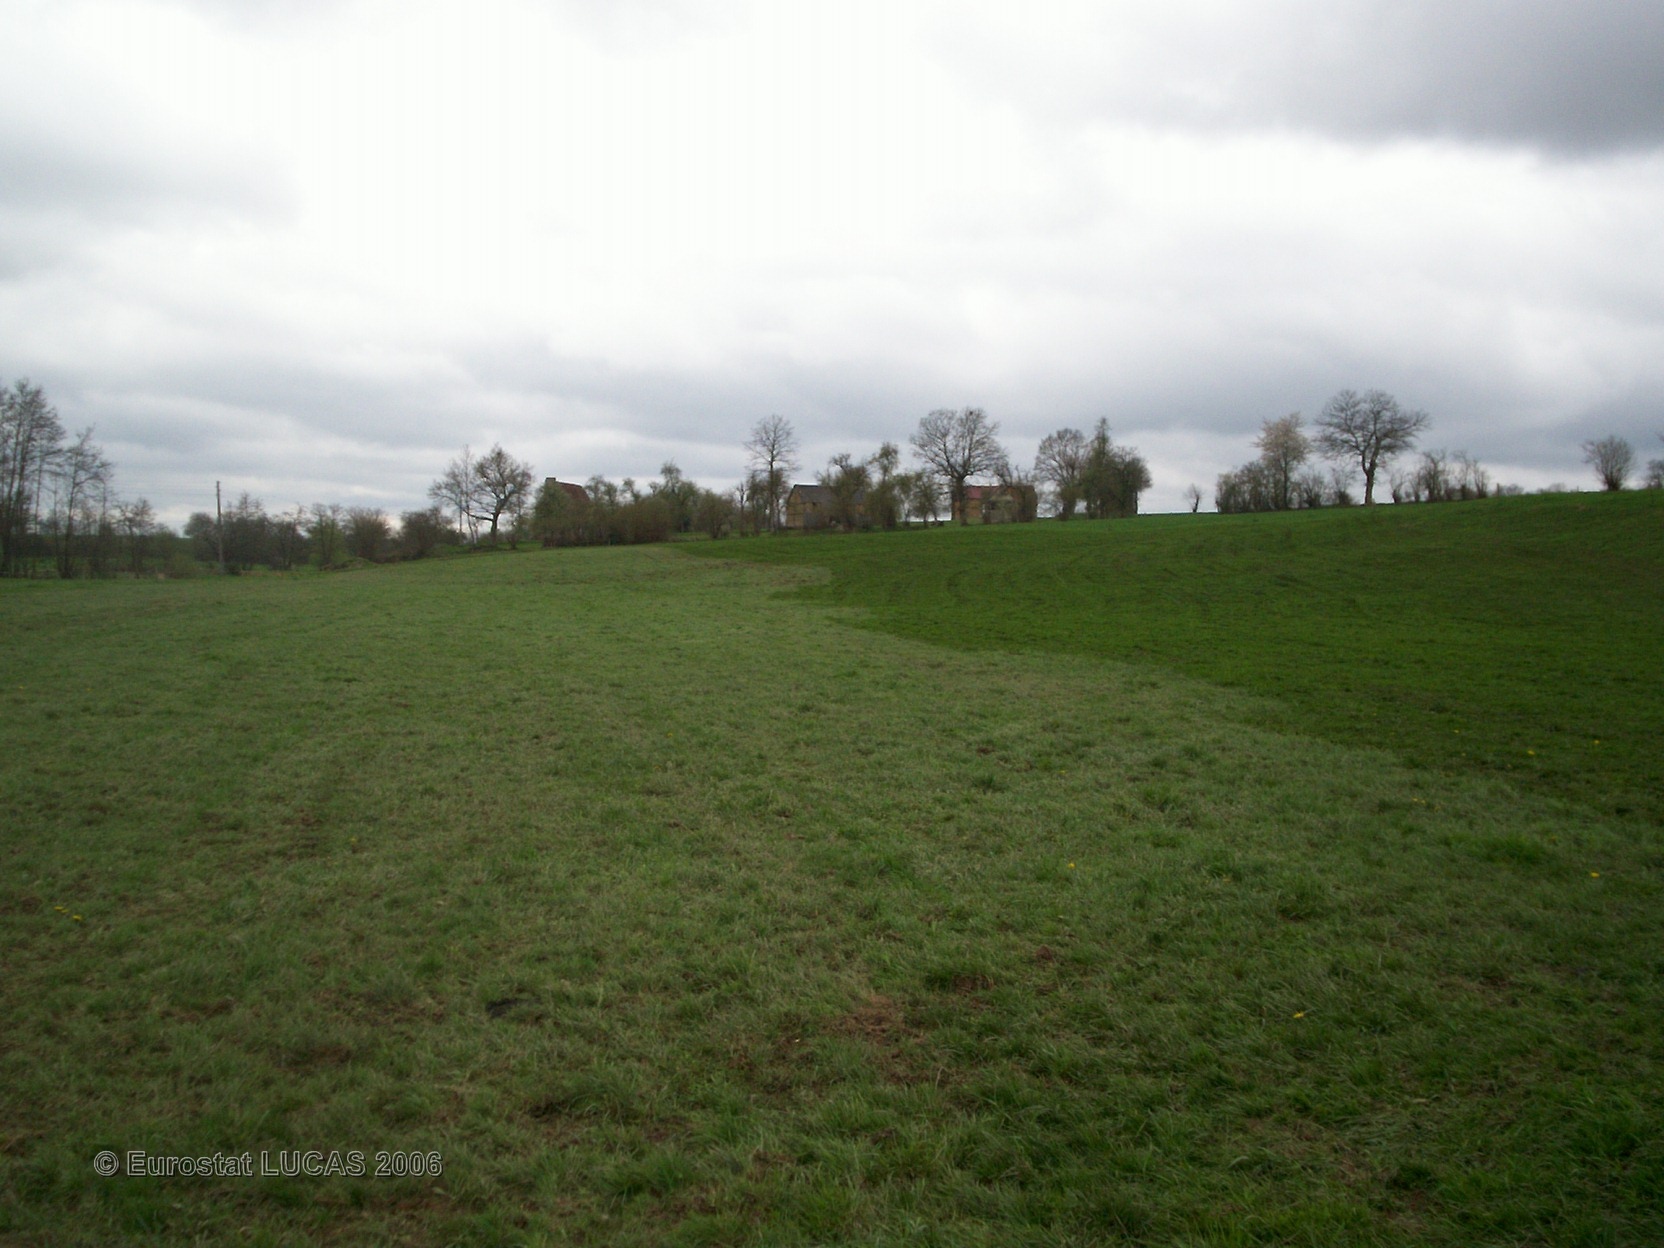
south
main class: Grassland
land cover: Grassland without tree/shrub cover
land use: Agriculture (excluding fallow land and kitchen gardens)
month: April
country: FR
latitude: 48.7146
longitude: -0.3495
